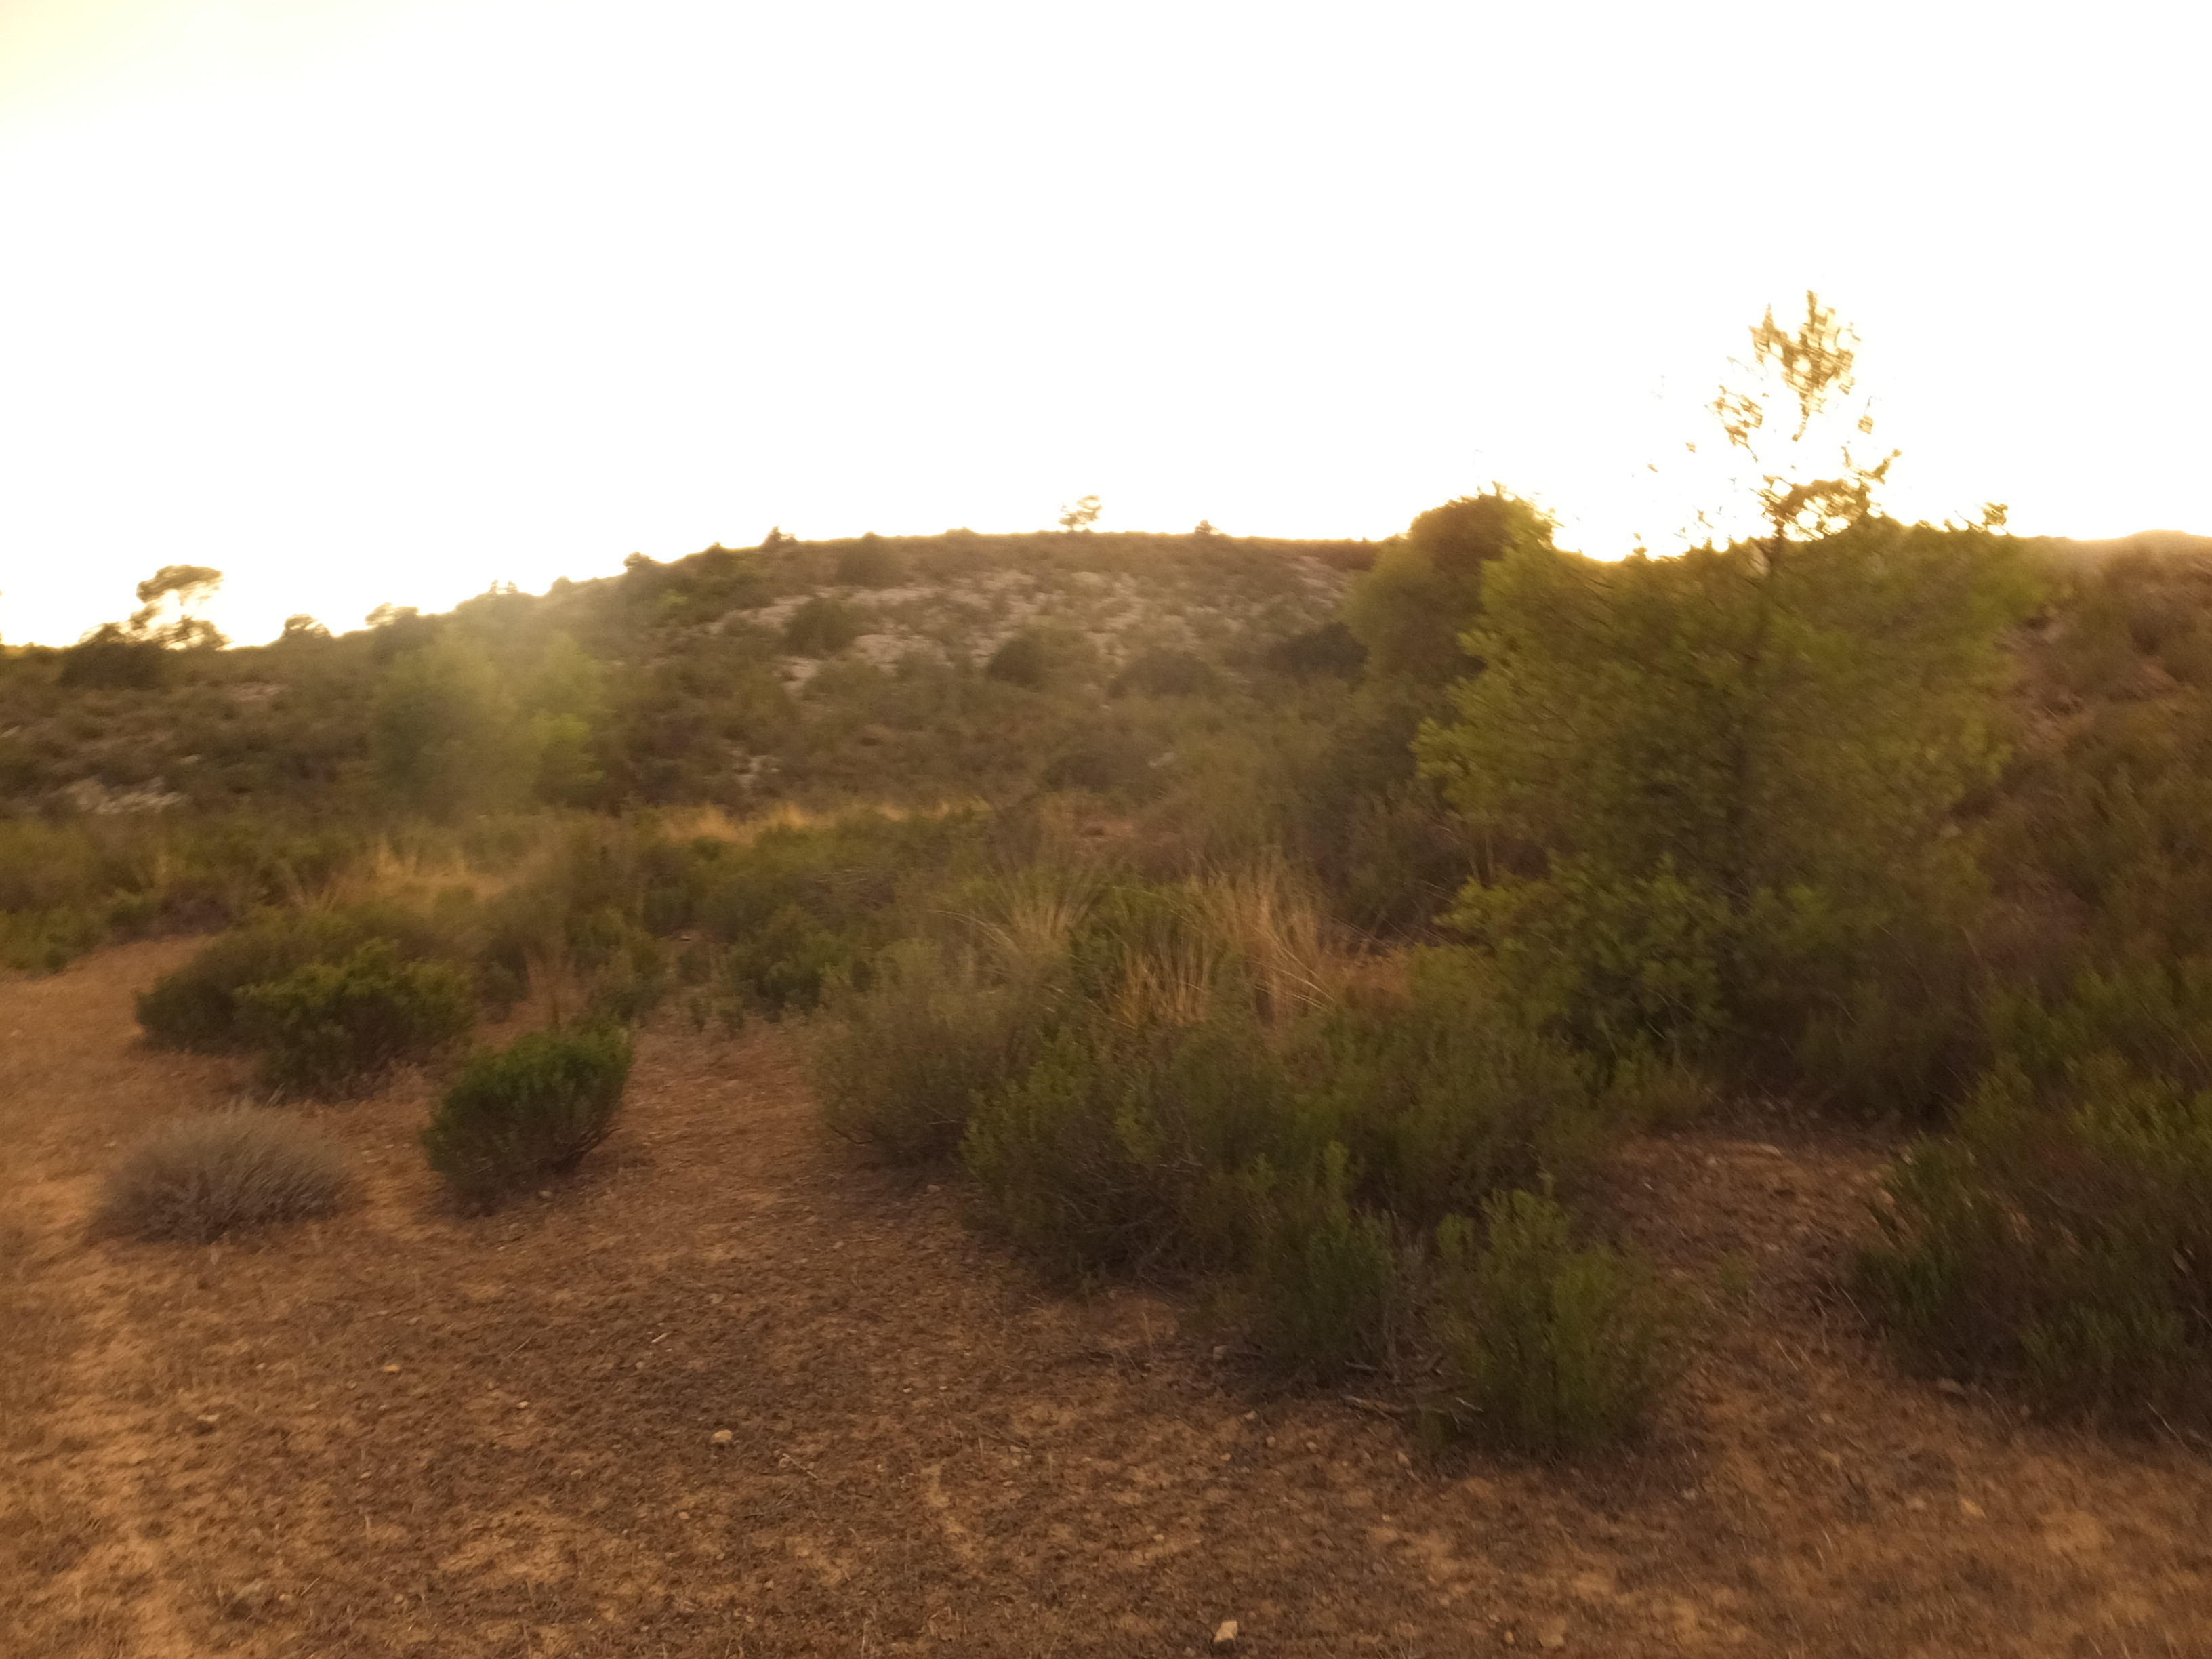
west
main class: Shrubland
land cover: Shrubland with sparse tree cover
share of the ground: > 75 %
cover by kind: shrubs 70 %, herbaceous plants 20 %, coniferous forest trees 5 %, consolidated bare surface 5 %
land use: Semi-natural and natural areas not in use
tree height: < 5 m
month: August
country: ES
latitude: 41.3473
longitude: 0.0794
